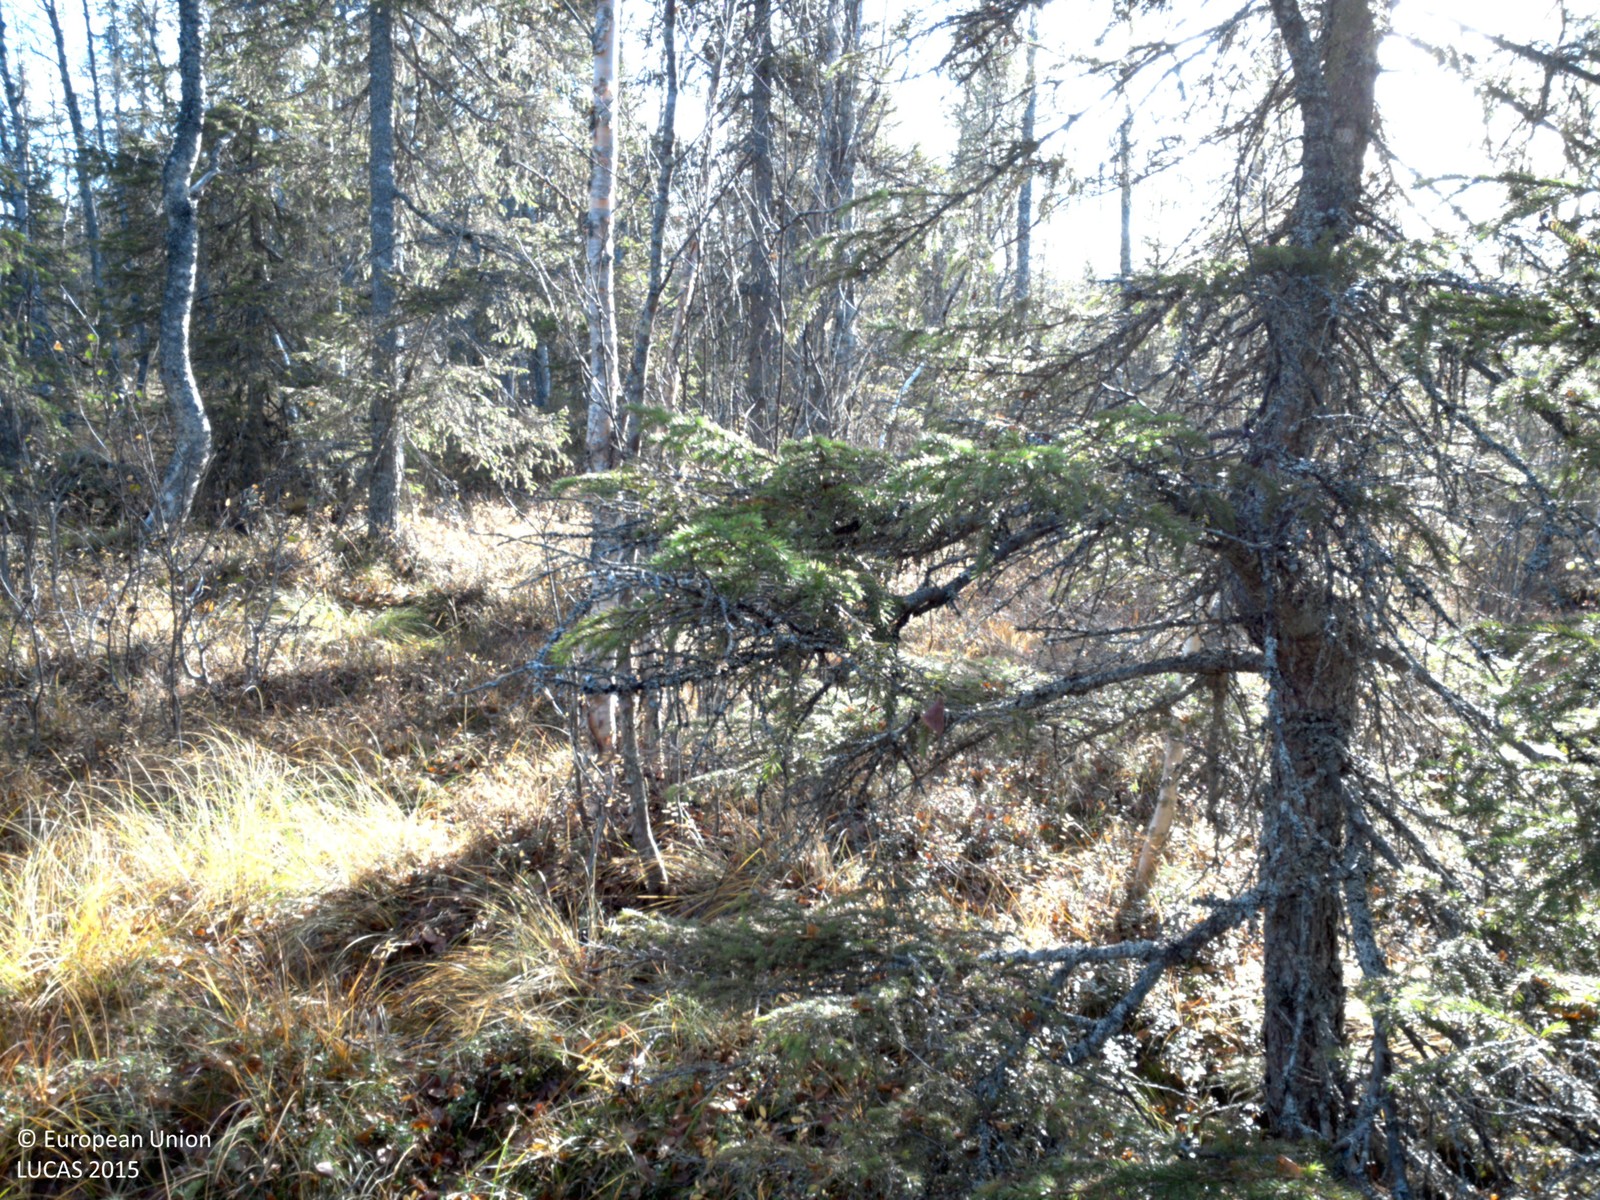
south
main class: Woodland
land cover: Spruce dominated mixed woodland
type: boreal forest
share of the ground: 25 - 50 %
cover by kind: coniferous forest trees 30 %, shrubs 30 %, herbaceous plants 15 %, lichens and mosses 15 %, broadleaved forest trees 10 %
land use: Forestry
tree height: > 5 m
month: October
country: SE
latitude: 64.7848
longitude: 17.8544
